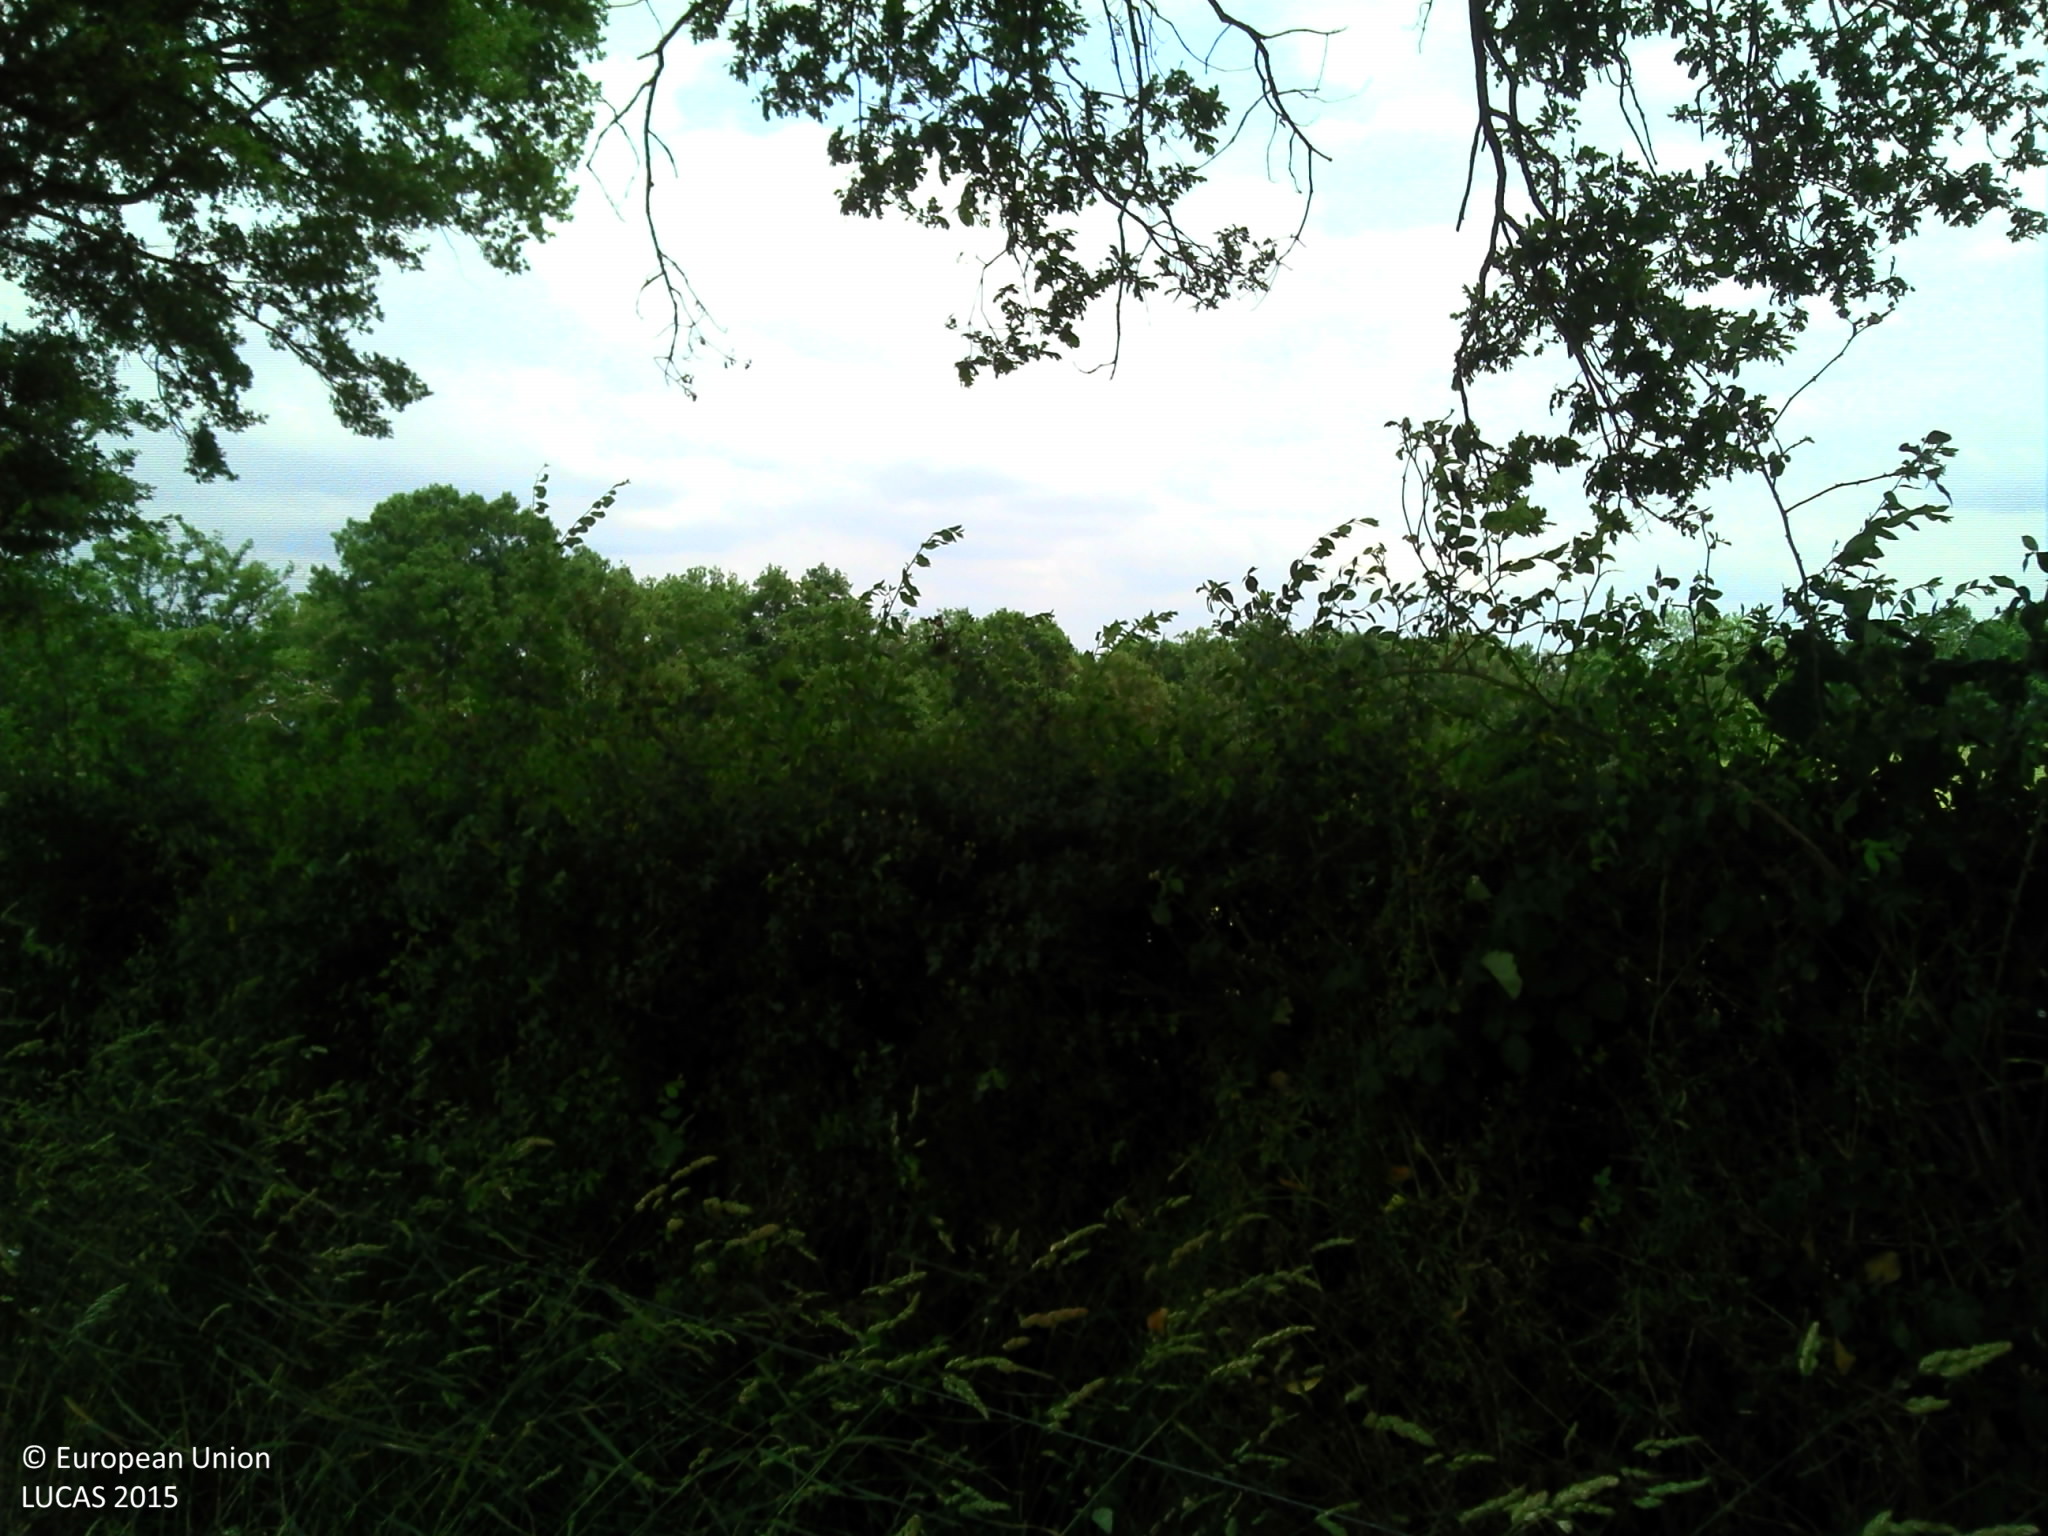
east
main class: Cropland
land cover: Temporary grasslands
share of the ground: > 75 %
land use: Agriculture (excluding fallow land and kitchen gardens)
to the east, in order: Temporary grasslands; Fences; Managed hedges; Fences; Grassland without tree/shrub cover; Fences; Lines of trees; Fences; Tracks; Managed hedges; Lines of trees; Ditches and canals; Tracks; Fences; Managed hedges; Grassland without tree/shrub cover
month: June
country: FR
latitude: 46.4194
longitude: 2.8537
